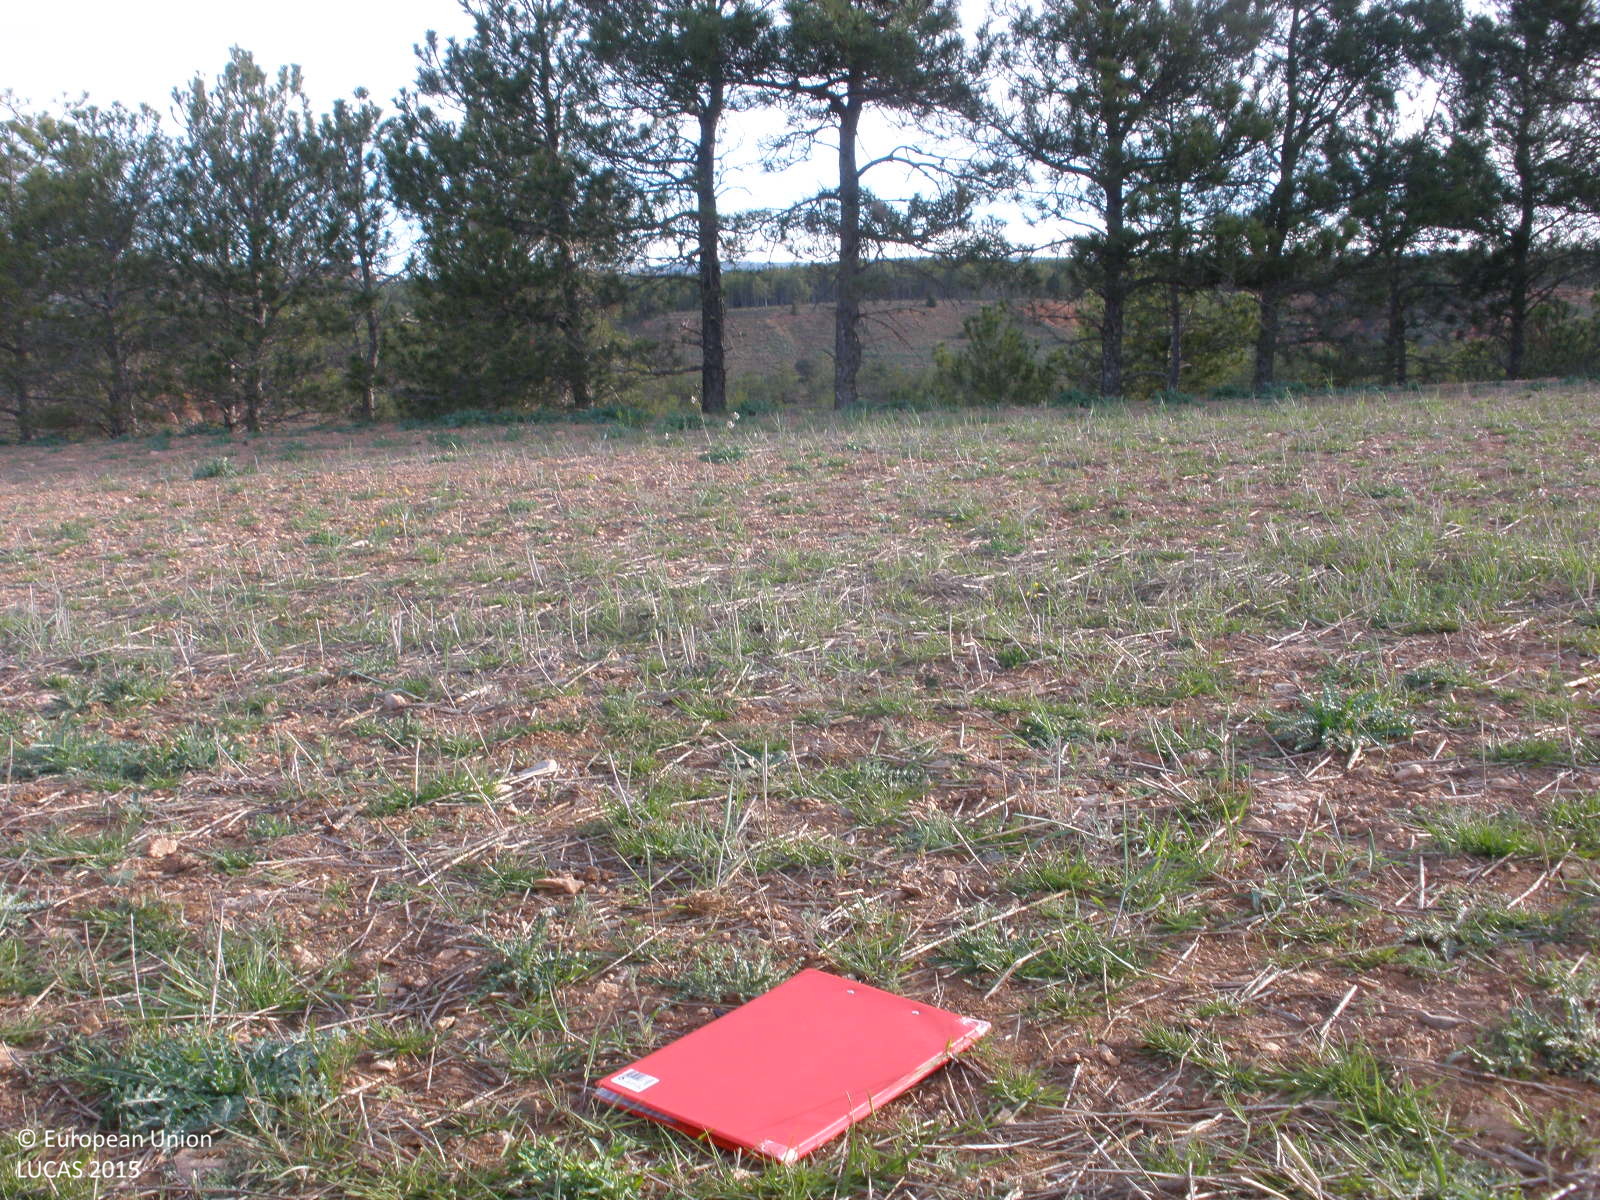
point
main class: Grassland
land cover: Spontaneously vegetated surfaces
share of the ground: > 75 %
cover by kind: herbaceous plants 85 %, unconsolidated bare surface 15 %
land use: Agriculture (excluding fallow land and kitchen gardens)
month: April
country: ES
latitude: 40.3150
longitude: -1.0597
